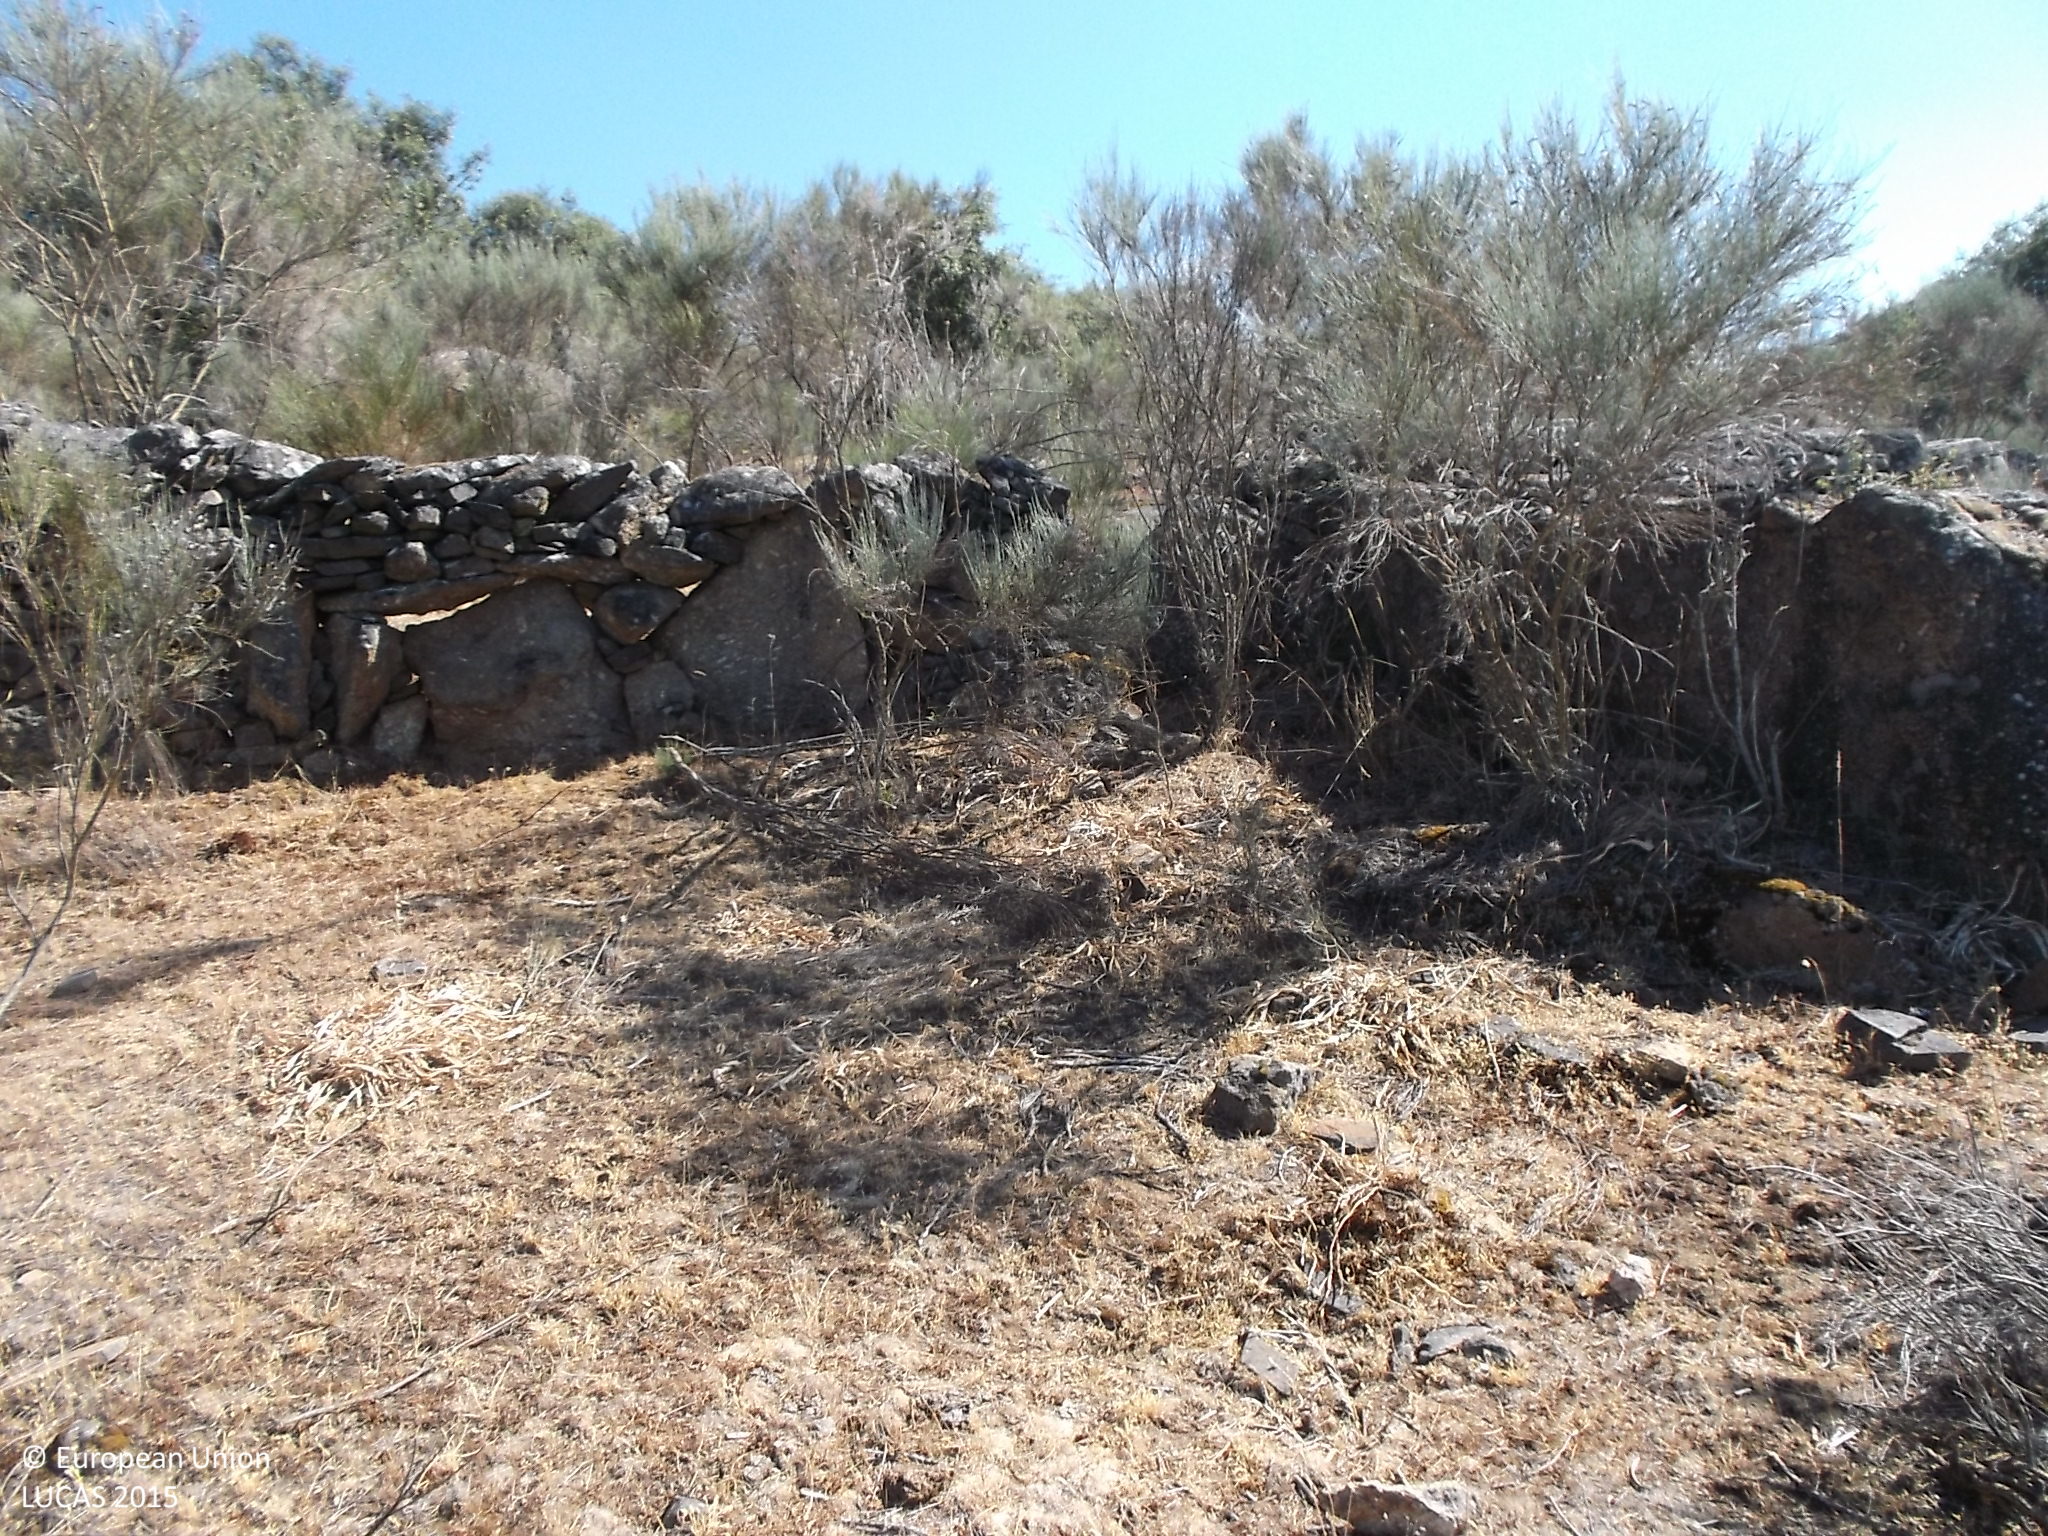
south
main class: Shrubland
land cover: Shrubland without tree cover
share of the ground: > 75 %
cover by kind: shrubs 90 %, consolidated bare surface 10 %
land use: Agriculture (excluding fallow land and kitchen gardens)
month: July
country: ES
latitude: 40.8188
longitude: -6.7803
